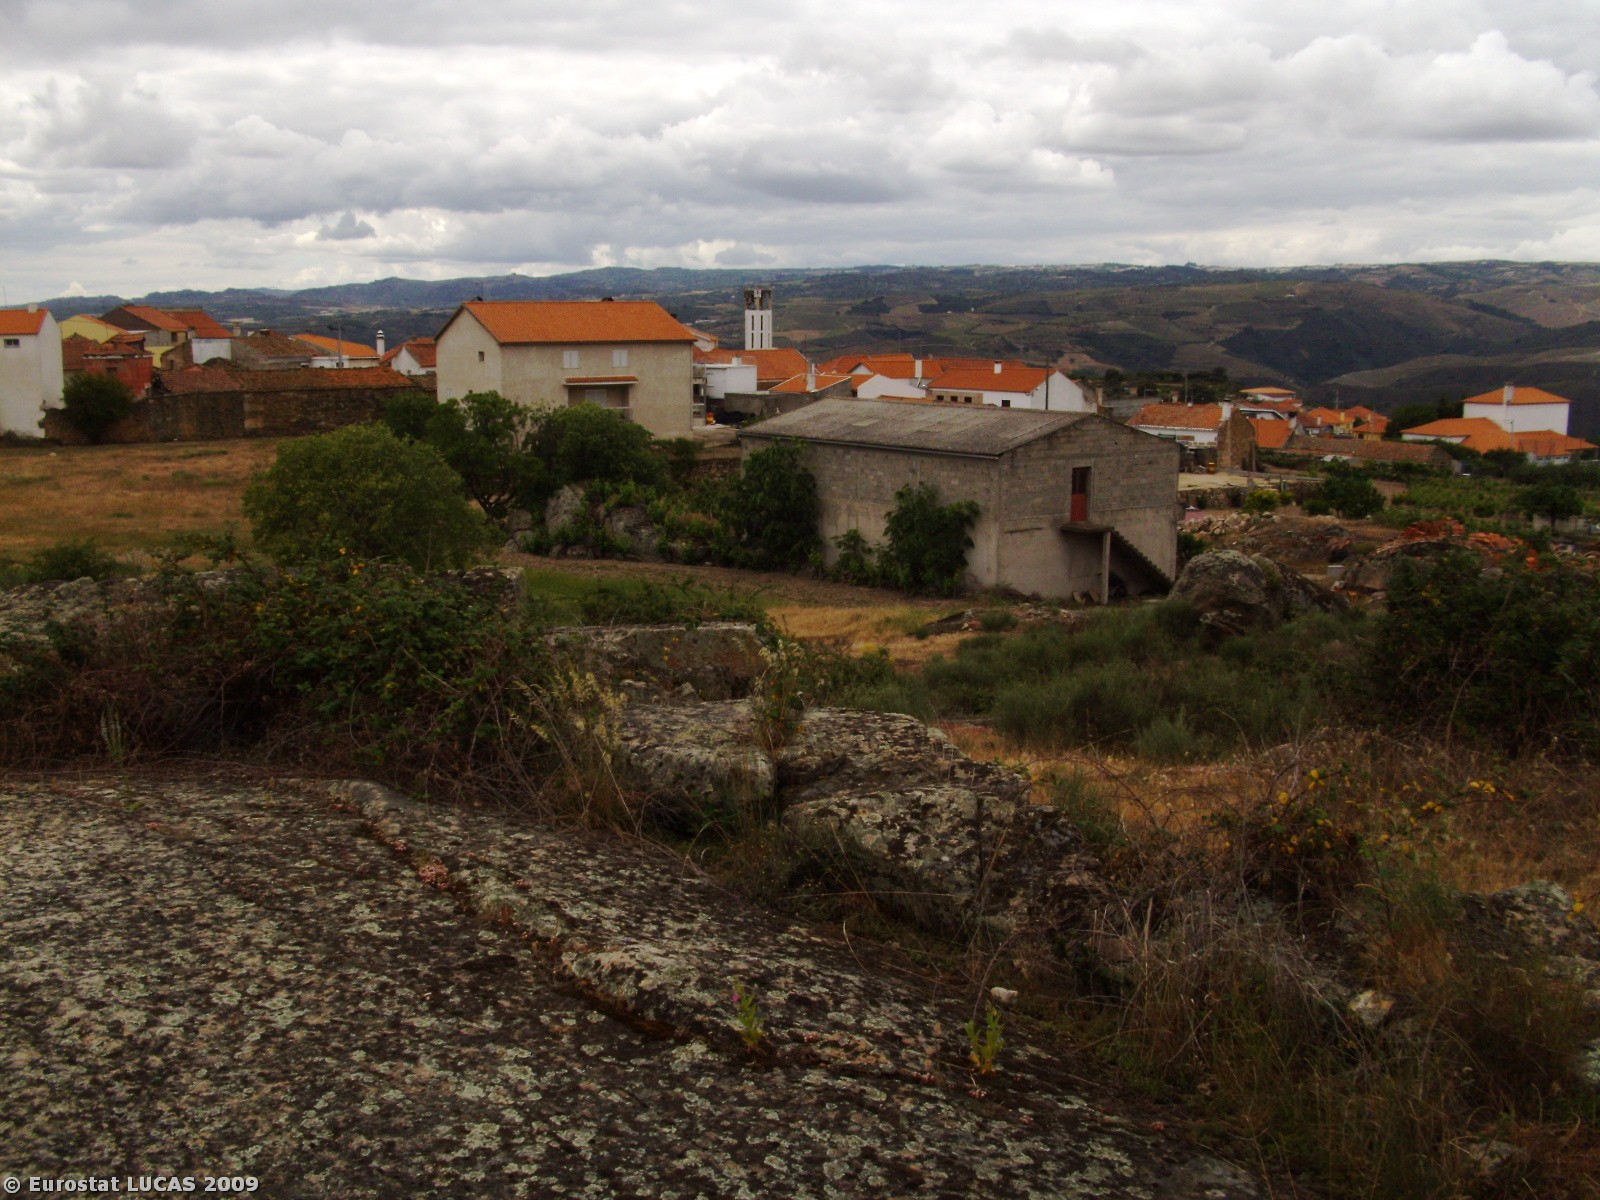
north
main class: Shrubland
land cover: Shrubland without tree cover
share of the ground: 25 - 50 %
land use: Unused
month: May
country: PT
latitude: 40.9909
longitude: -7.1684
